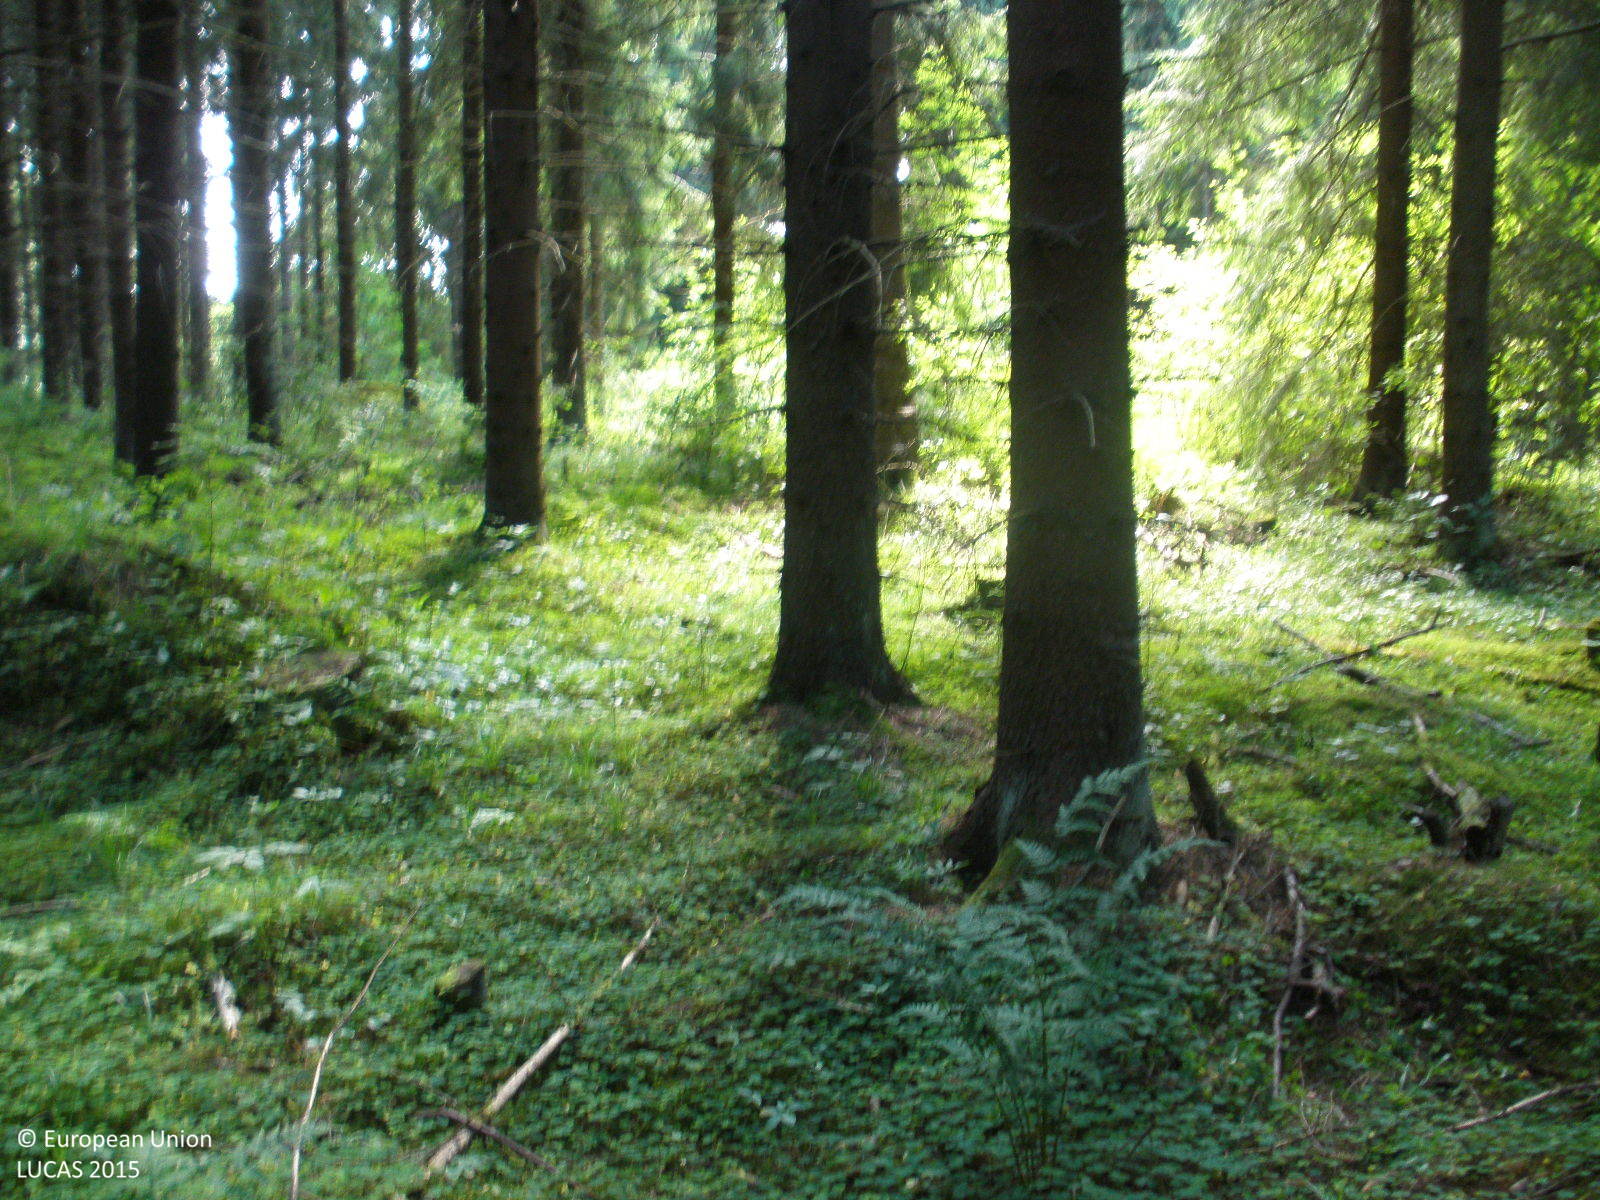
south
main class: Woodland
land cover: Spruce dominated coniferous woodland
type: boreal forest
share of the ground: > 75 %
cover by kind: coniferous forest trees 85 %, lichens and mosses 10 %, herbaceous plants 5 %
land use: Forestry
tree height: > 5 m
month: July
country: FI
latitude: 61.1067
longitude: 24.9351
